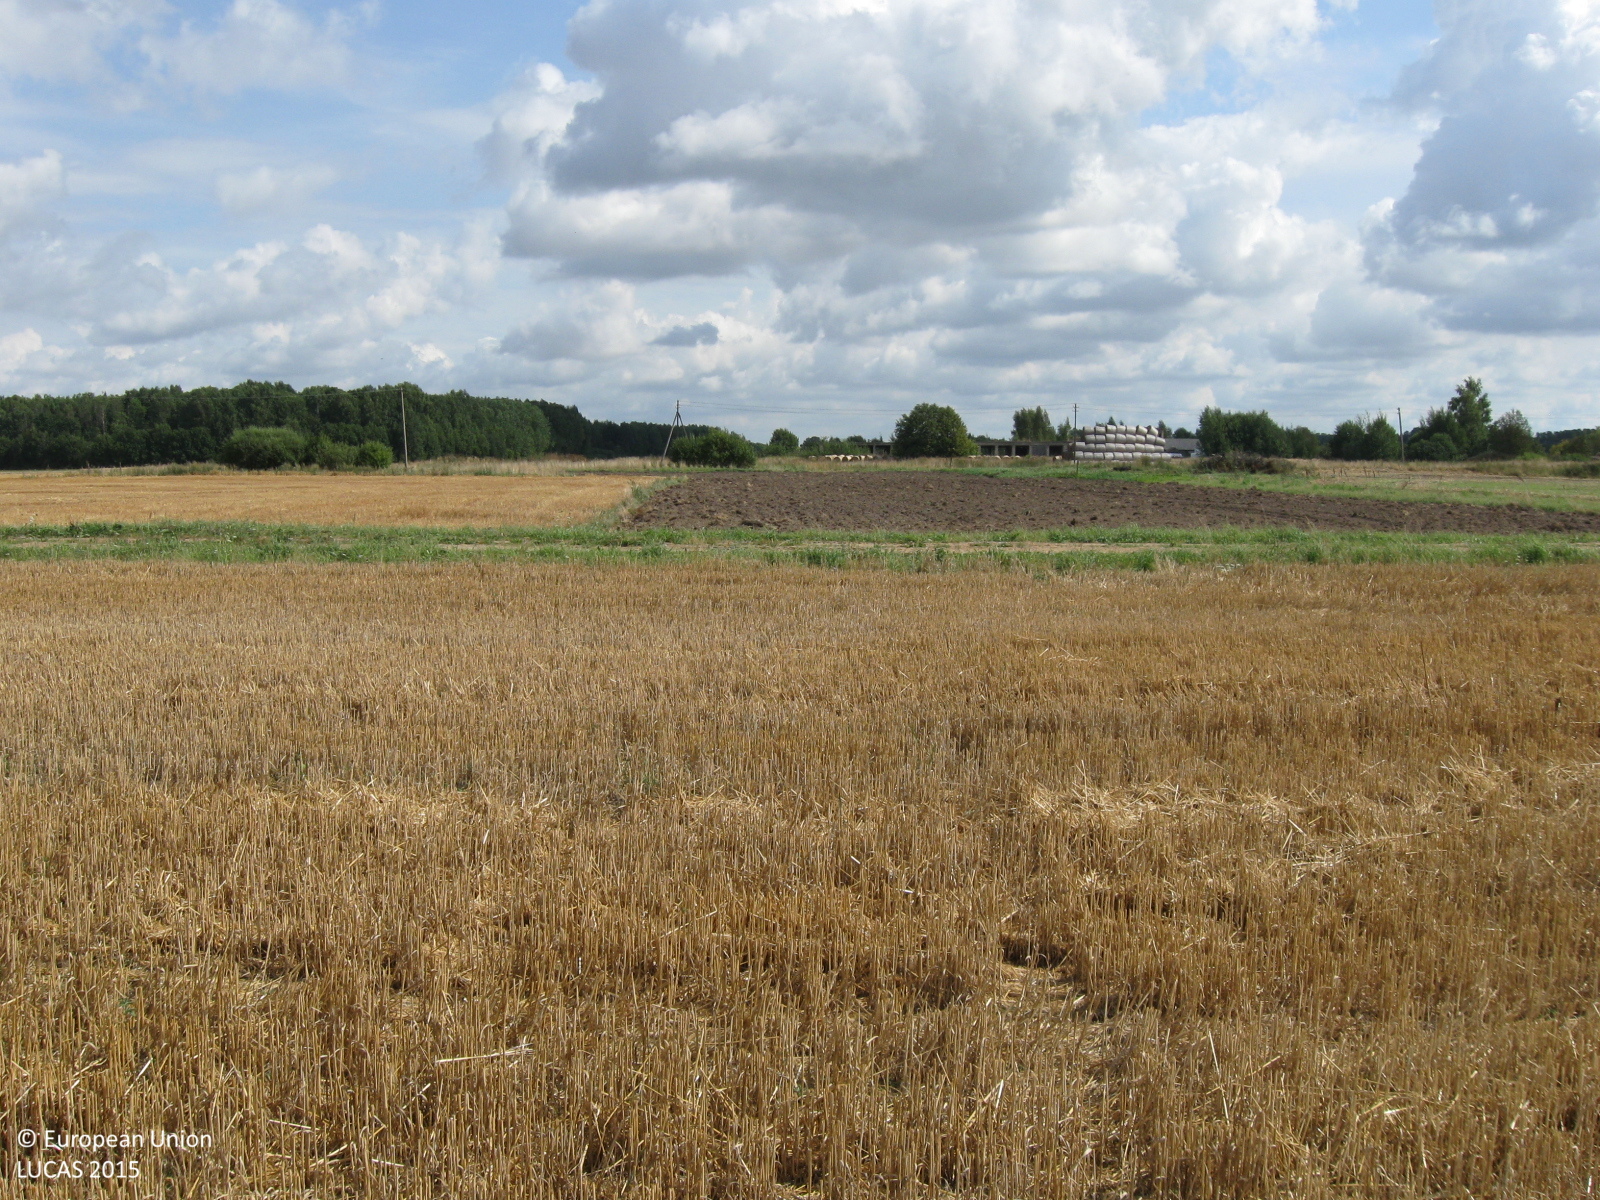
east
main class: Cropland
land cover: Common wheat
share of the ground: > 75 %
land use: Agriculture (excluding fallow land and kitchen gardens)
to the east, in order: Common wheat; Grass margins; Tracks; Grass margins; Other bare soil; Spontaneously vegetated surfaces; Tracks; Spontaneously vegetated surfaces; Electric lines; Spontaneously vegetated surfaces; Common wheat
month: August
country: LT
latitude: 55.2521
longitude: 23.1464
